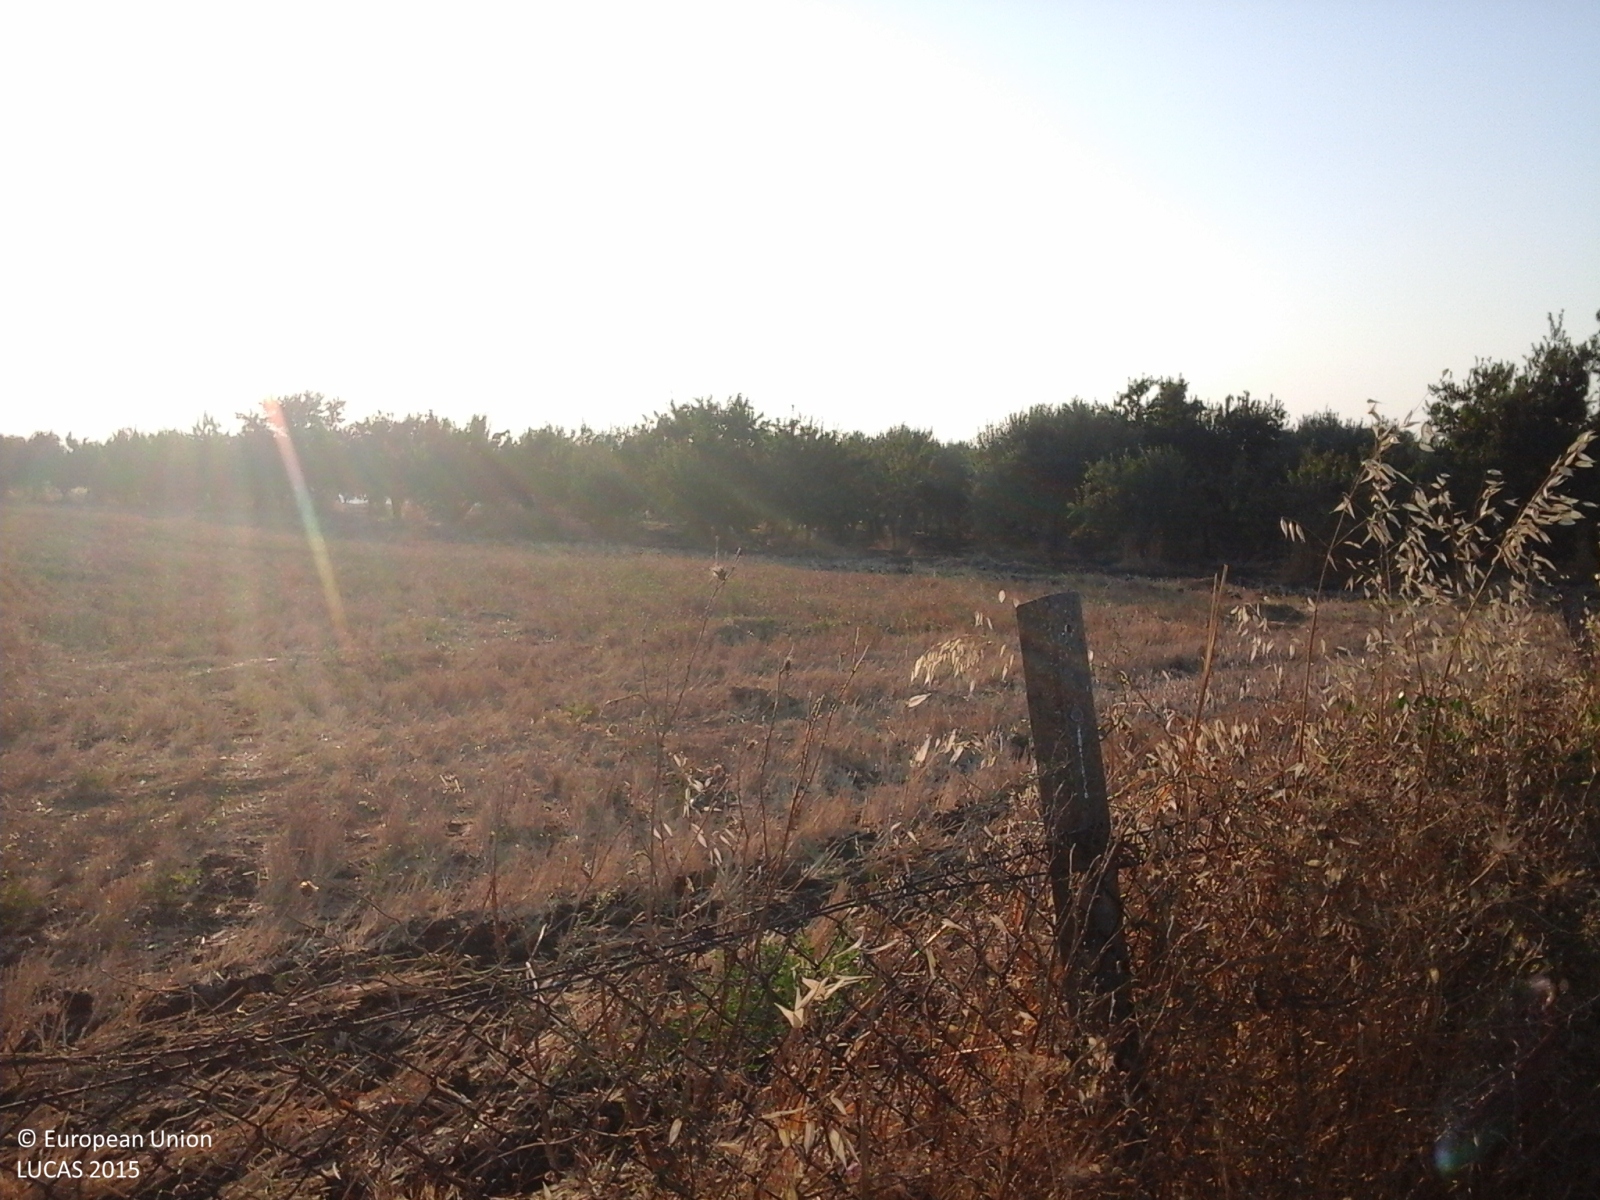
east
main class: Cropland
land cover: Durum wheat
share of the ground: > 75 %
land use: Agriculture (excluding fallow land and kitchen gardens)
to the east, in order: Durum wheat; Nuts trees; Olive groves; Durum wheat; Nuts trees
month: July
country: IT
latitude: 37.1893
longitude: 14.0351
